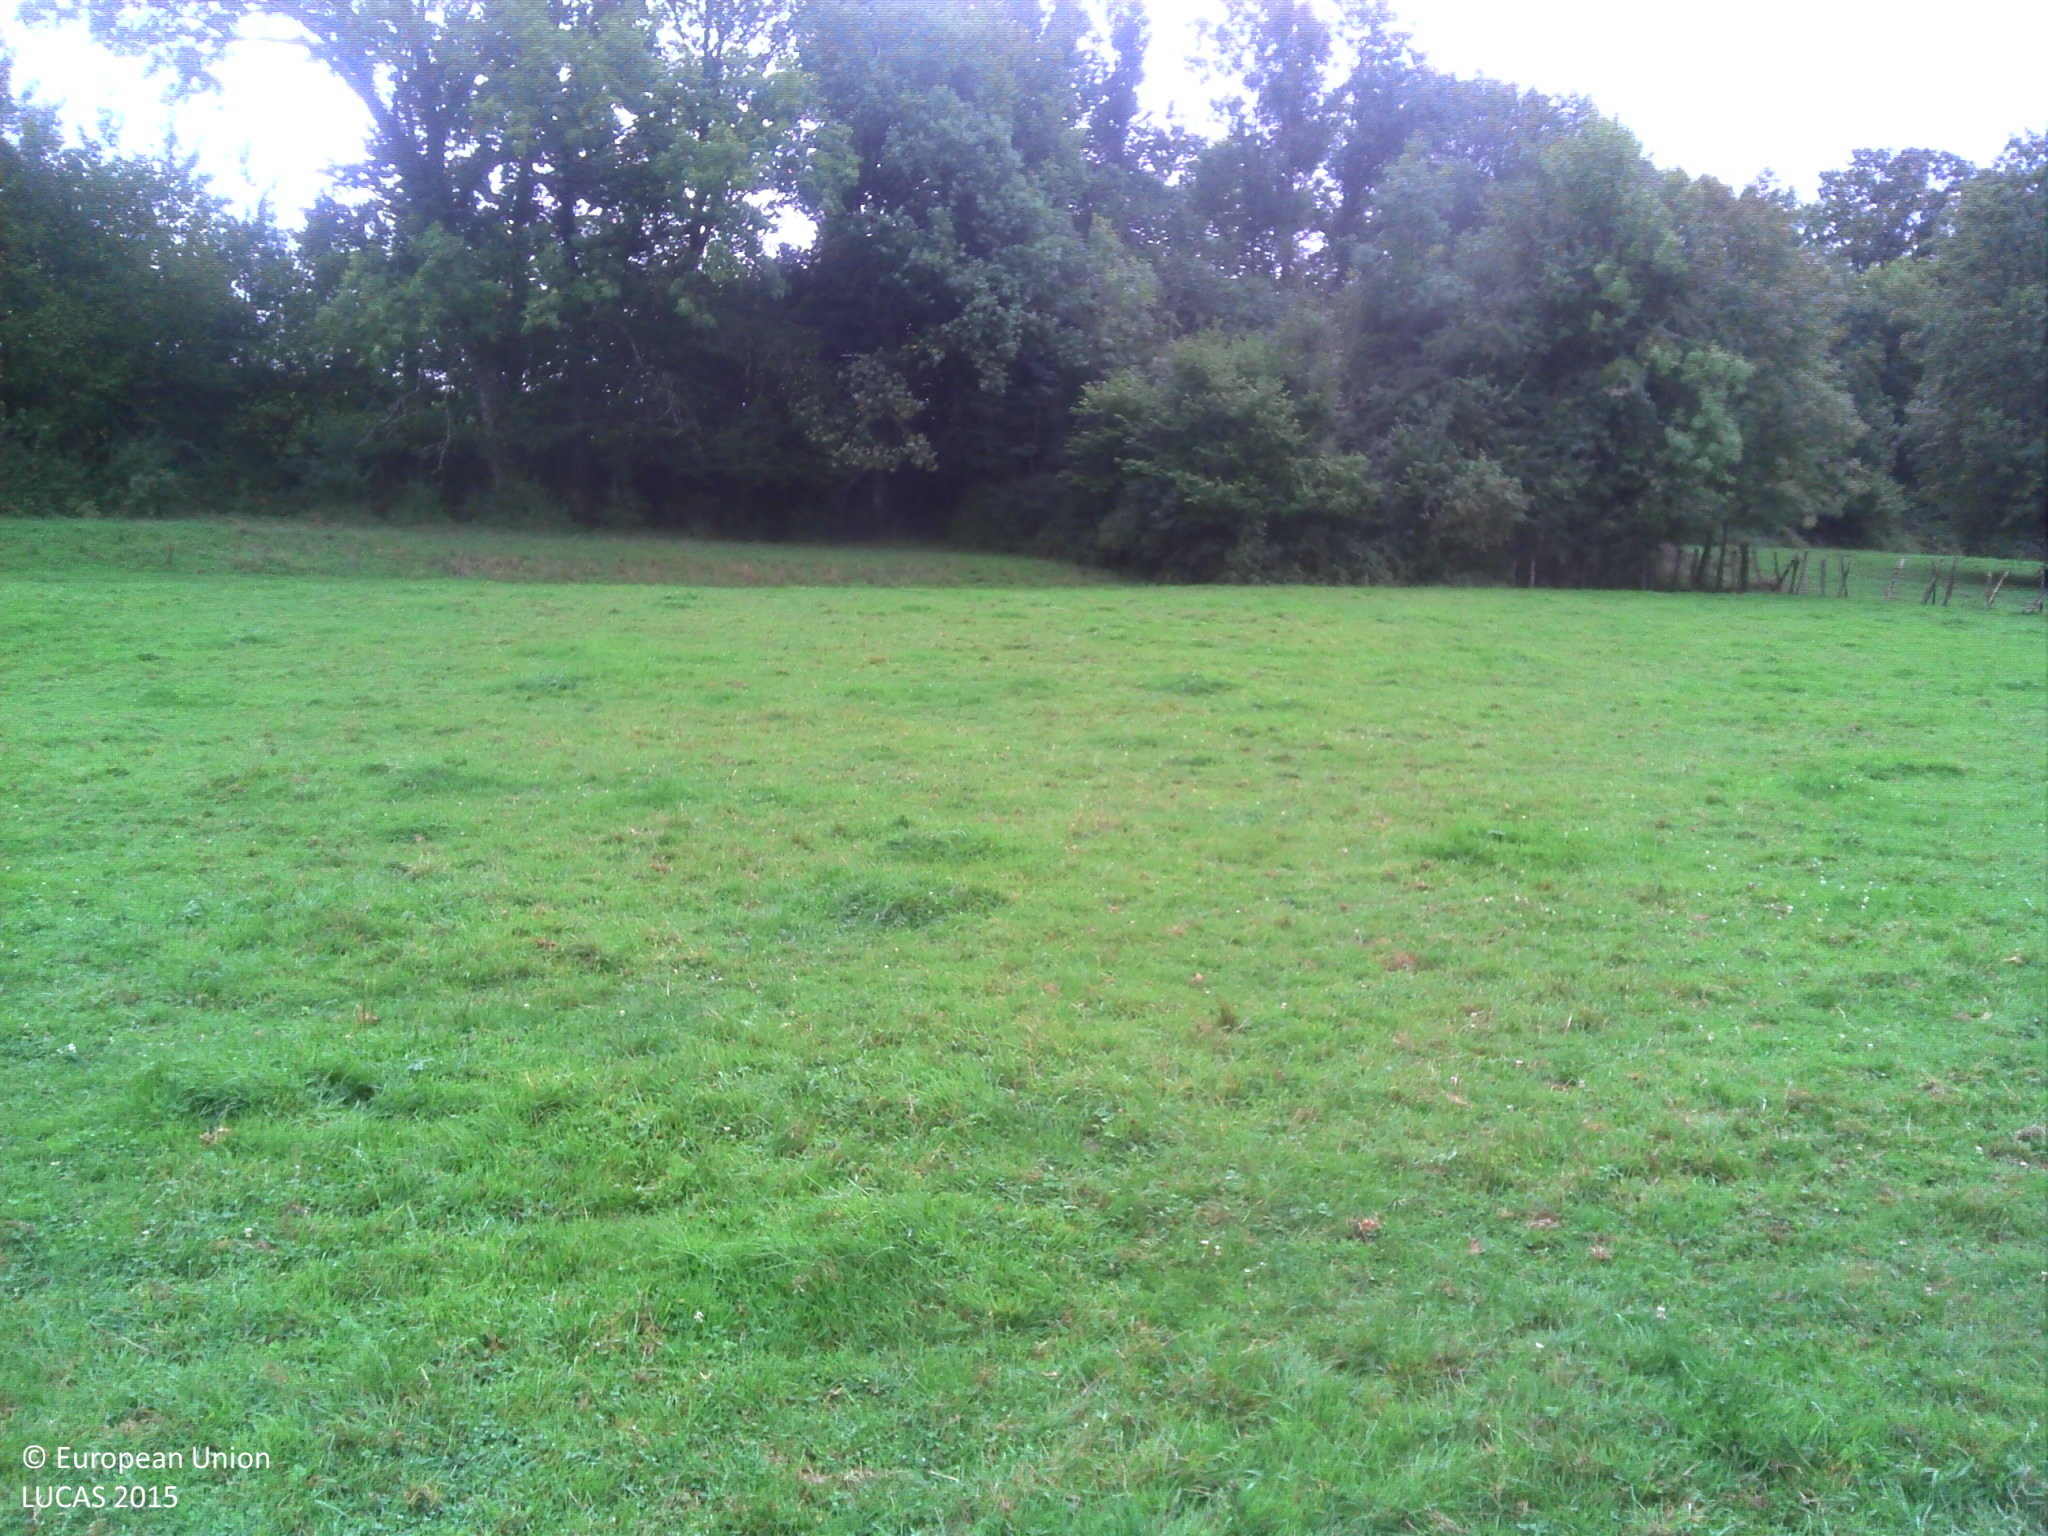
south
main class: Grassland
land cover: Grassland without tree/shrub cover
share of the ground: > 75 %
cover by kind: herbaceous plants 90 %, consolidated bare surface 10 %
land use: Agriculture (excluding fallow land and kitchen gardens)
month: September
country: FR
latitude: 47.1648
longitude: 6.1368
